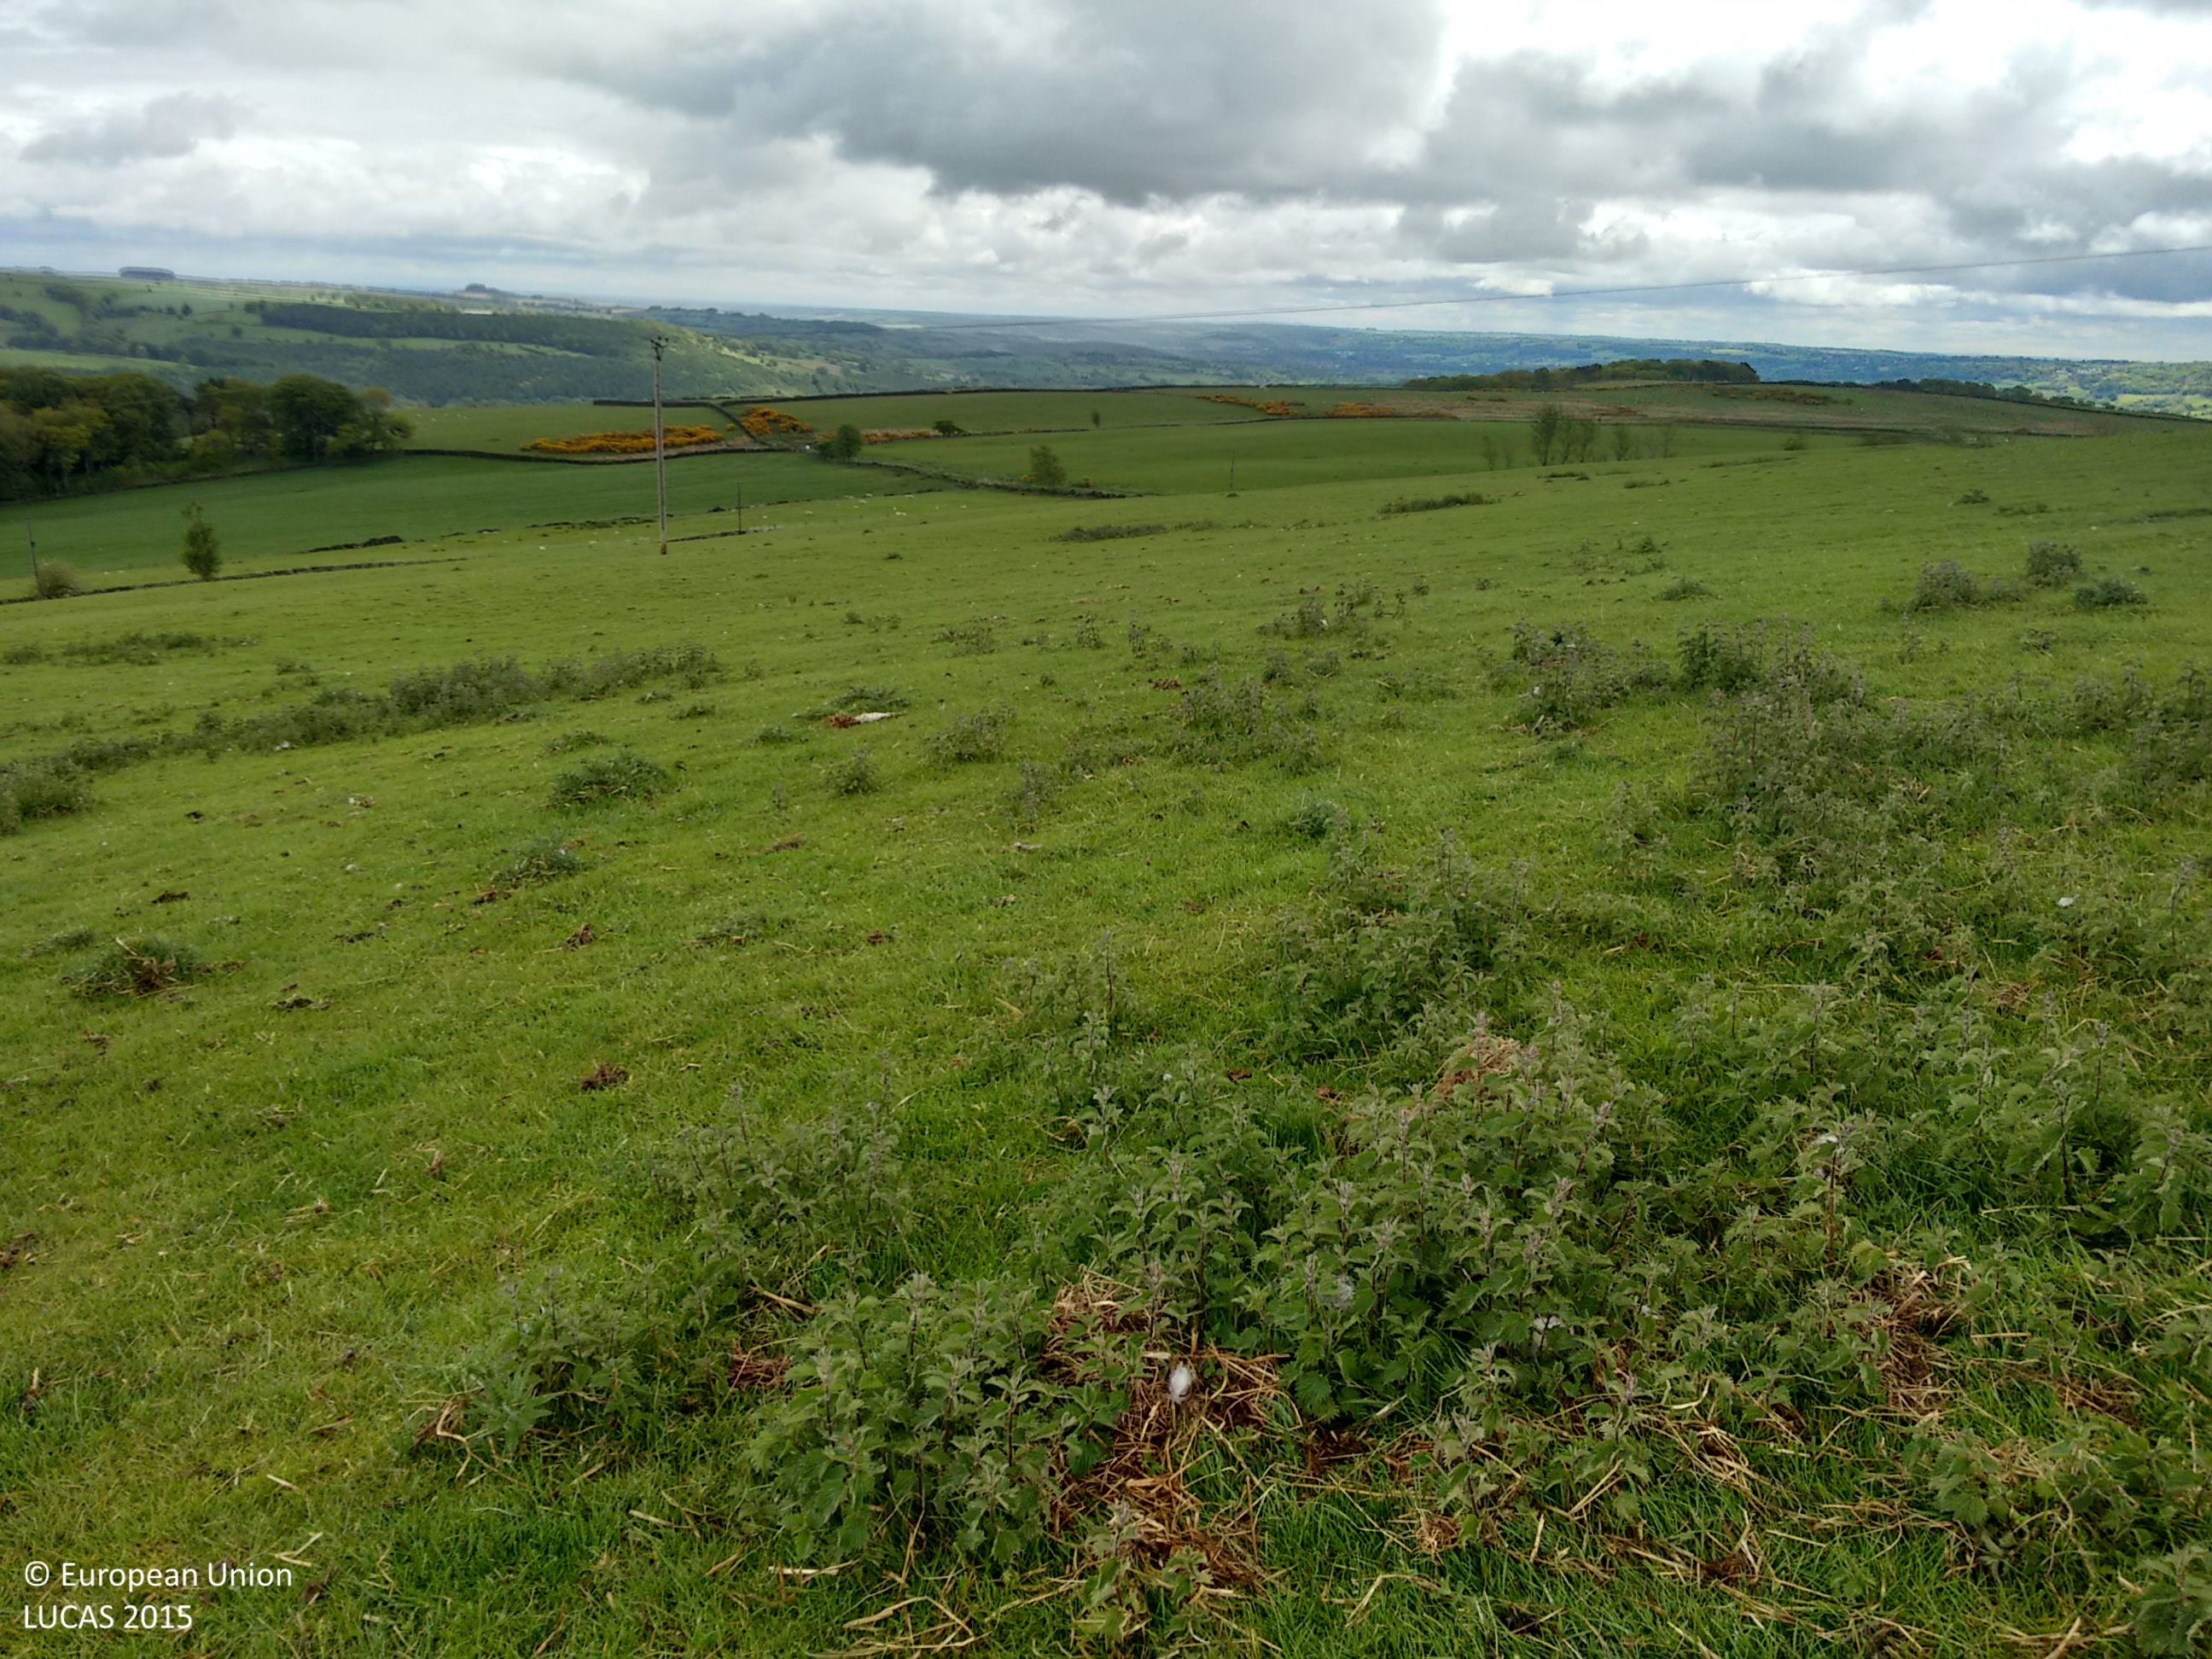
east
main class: Grassland
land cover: Grassland without tree/shrub cover
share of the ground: > 75 %
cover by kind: herbaceous plants 100 %
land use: Agriculture (excluding fallow land and kitchen gardens)
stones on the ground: < 10 %
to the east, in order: Grassland without tree/shrub cover; Electric lines; Fences; Dry stone walls; Grass margins; Paved roads, cycling and walking lanes; Grass margins; Dry stone walls; Grassland without tree/shrub cover
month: May
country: GB
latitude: 53.9406
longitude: -1.7064
